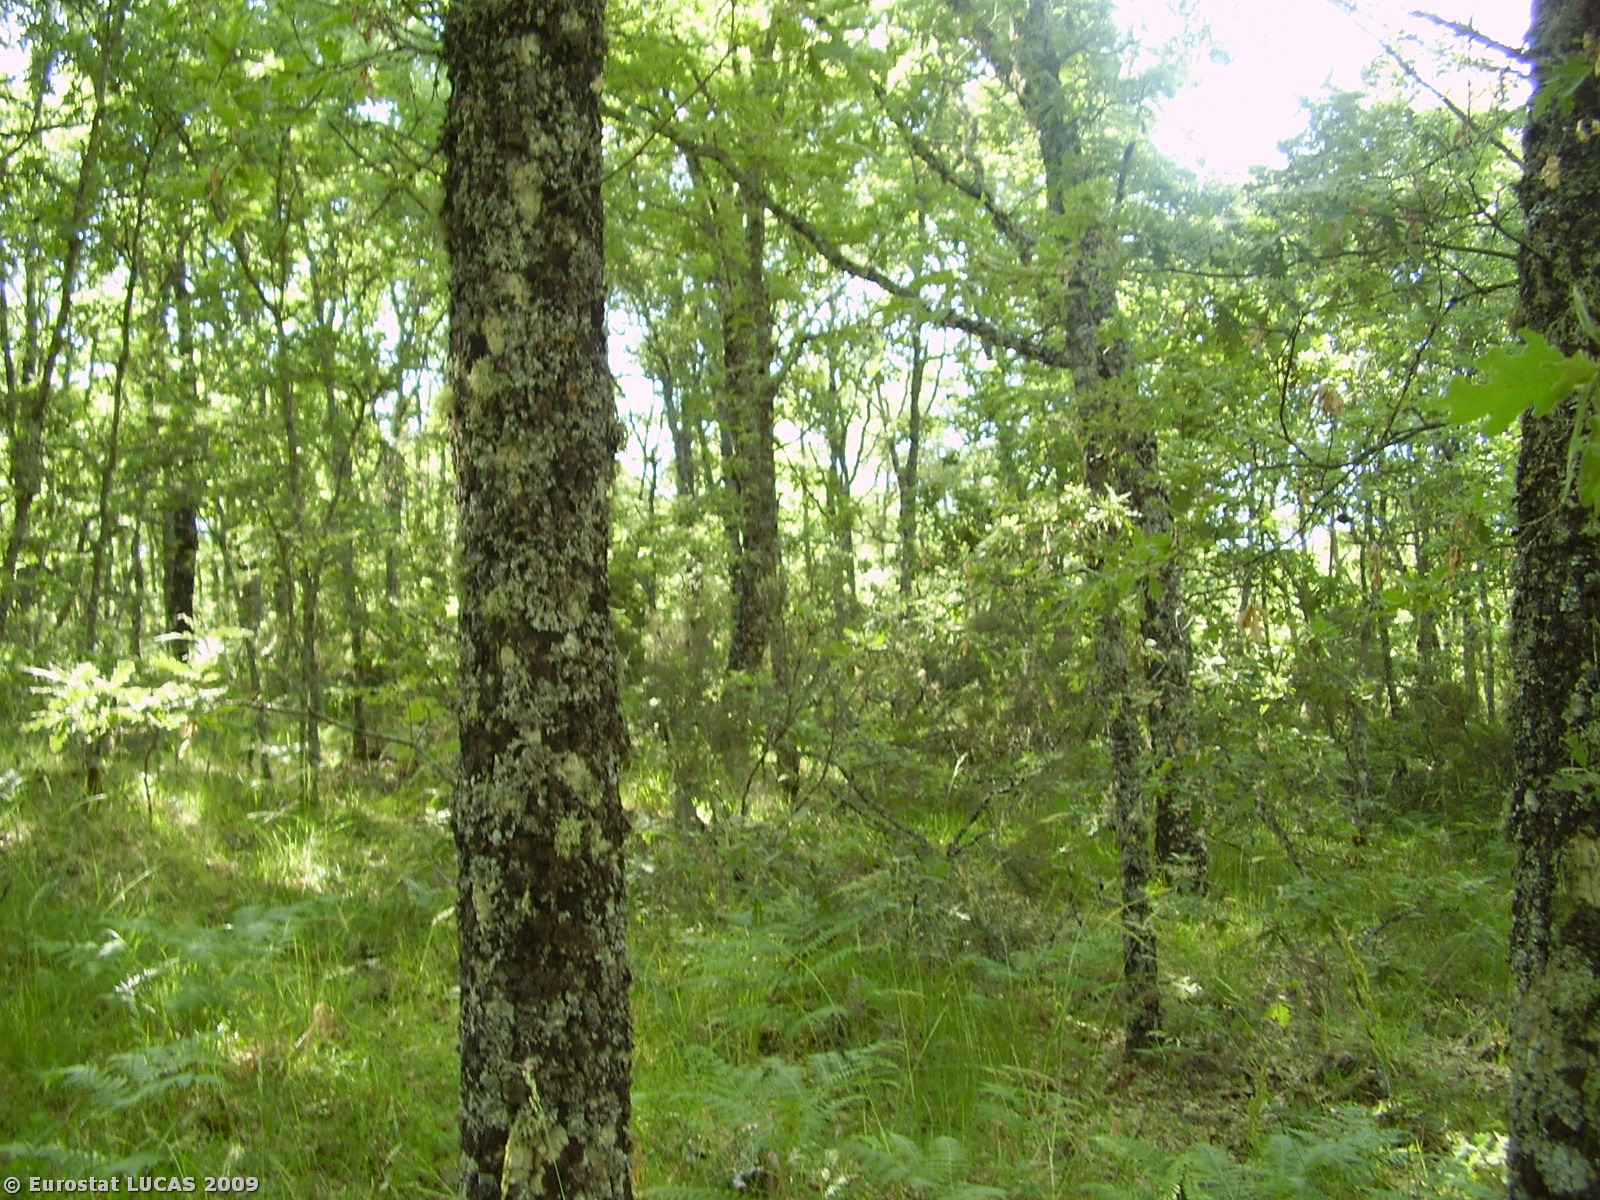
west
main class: Woodland
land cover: Broadleaved woodland
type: thermophilous deciduous forest
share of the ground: 50 - 75 %
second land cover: Spontaneously vegetated surfaces
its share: 25 - 50 %
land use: Forestry
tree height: > 5 m
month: June
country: PT
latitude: 41.8541
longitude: -6.9705
